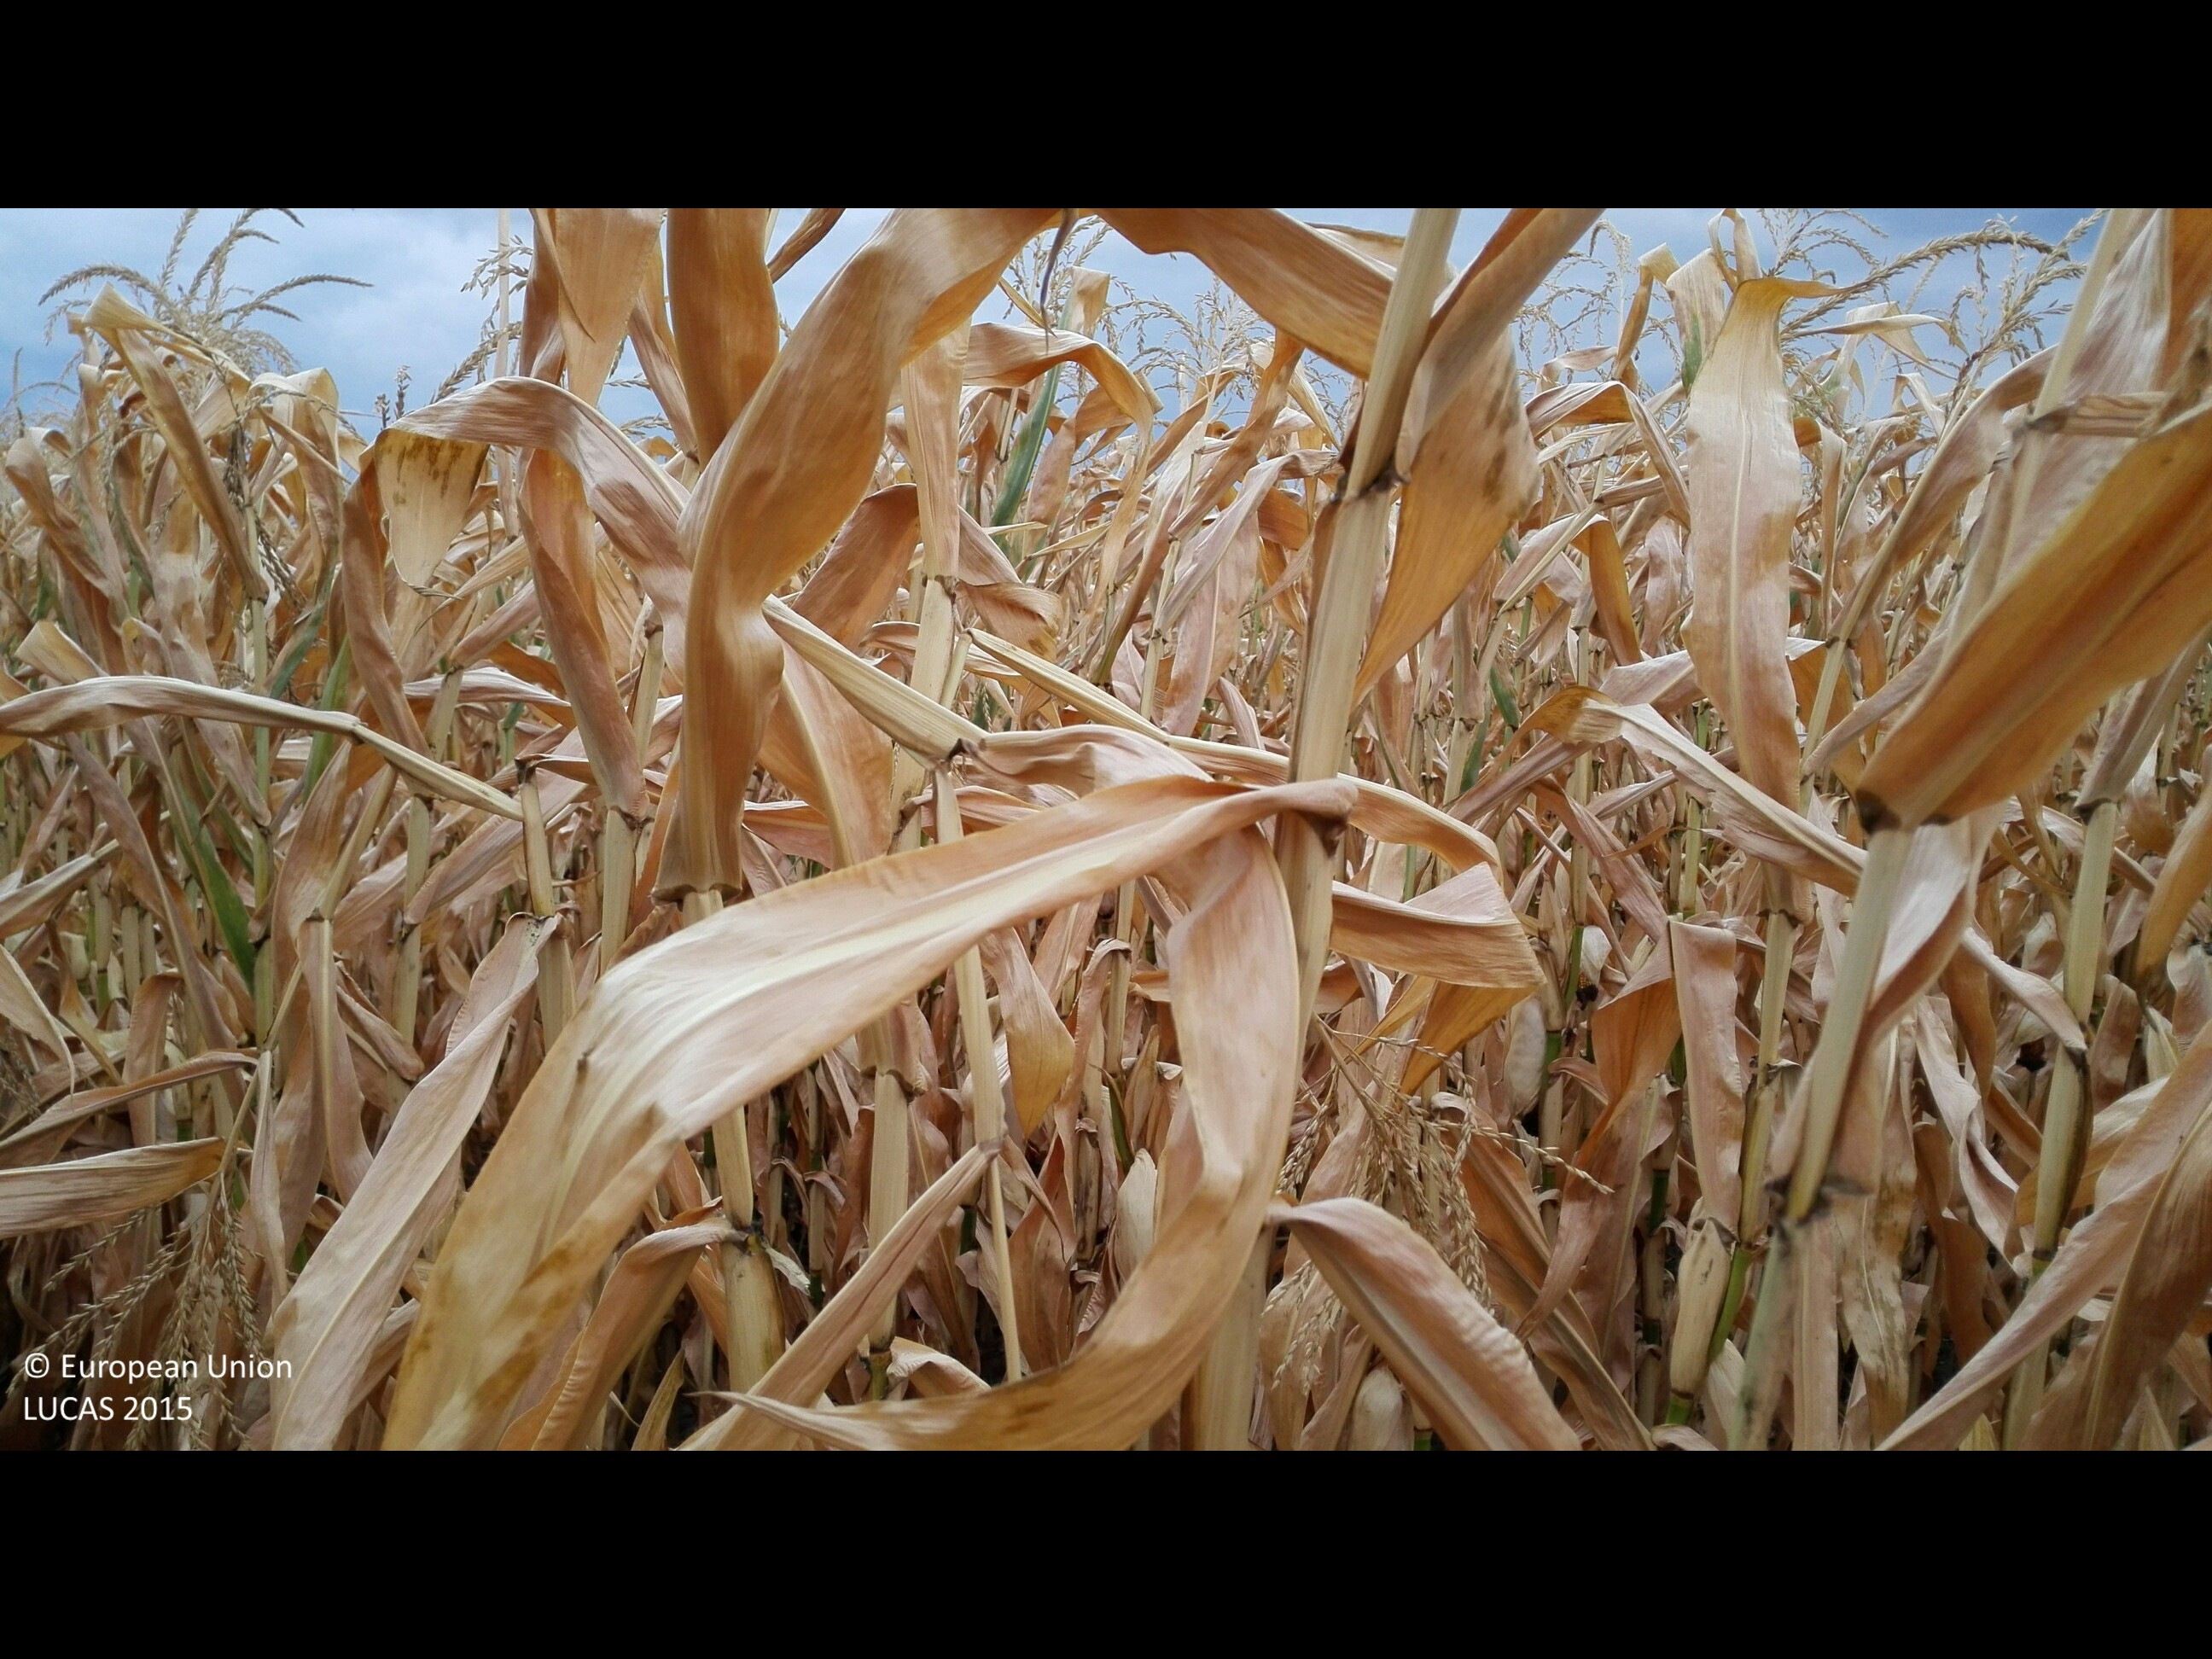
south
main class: Cropland
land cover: Maize
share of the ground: > 75 %
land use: Agriculture (excluding fallow land and kitchen gardens)
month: August
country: HU
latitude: 47.3010
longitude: 21.5888
